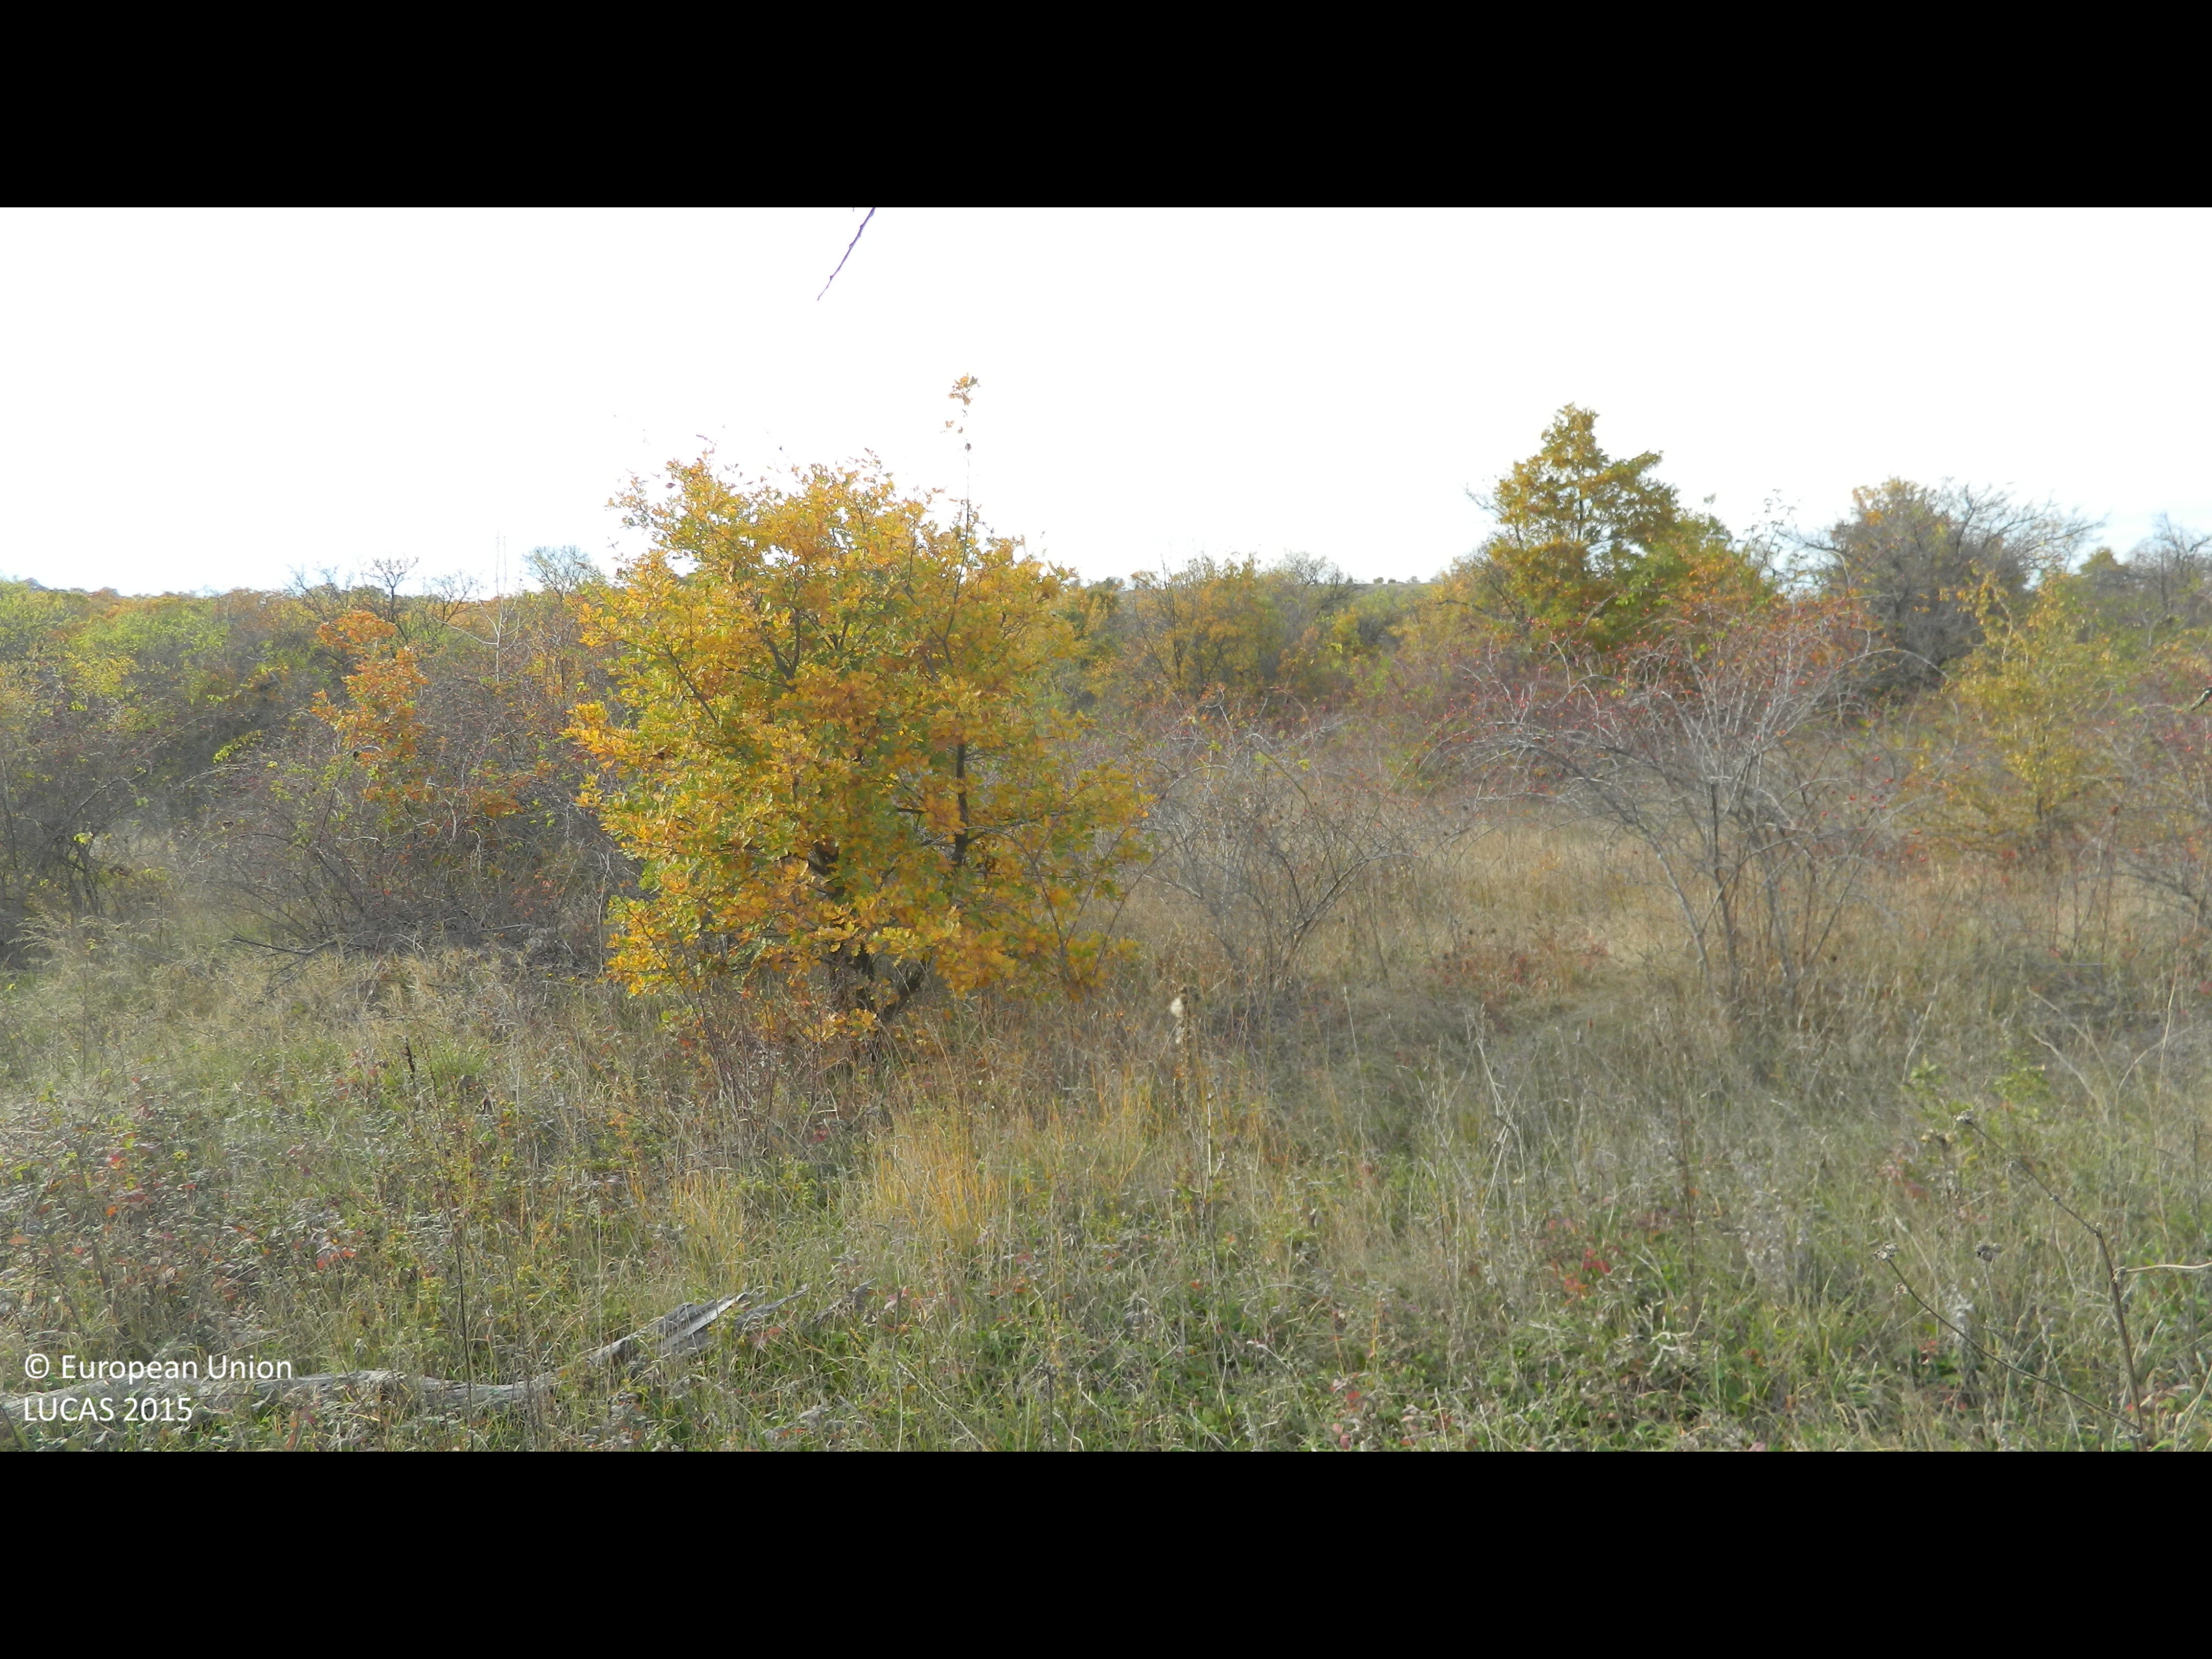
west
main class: Cropland
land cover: Nuts trees
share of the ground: 25 - 50 %
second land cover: Grassland without tree/shrub cover
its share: > 75 %
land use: Agriculture (excluding fallow land and kitchen gardens)
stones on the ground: < 10 %
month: November
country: BG
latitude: 41.4562
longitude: 26.0500
